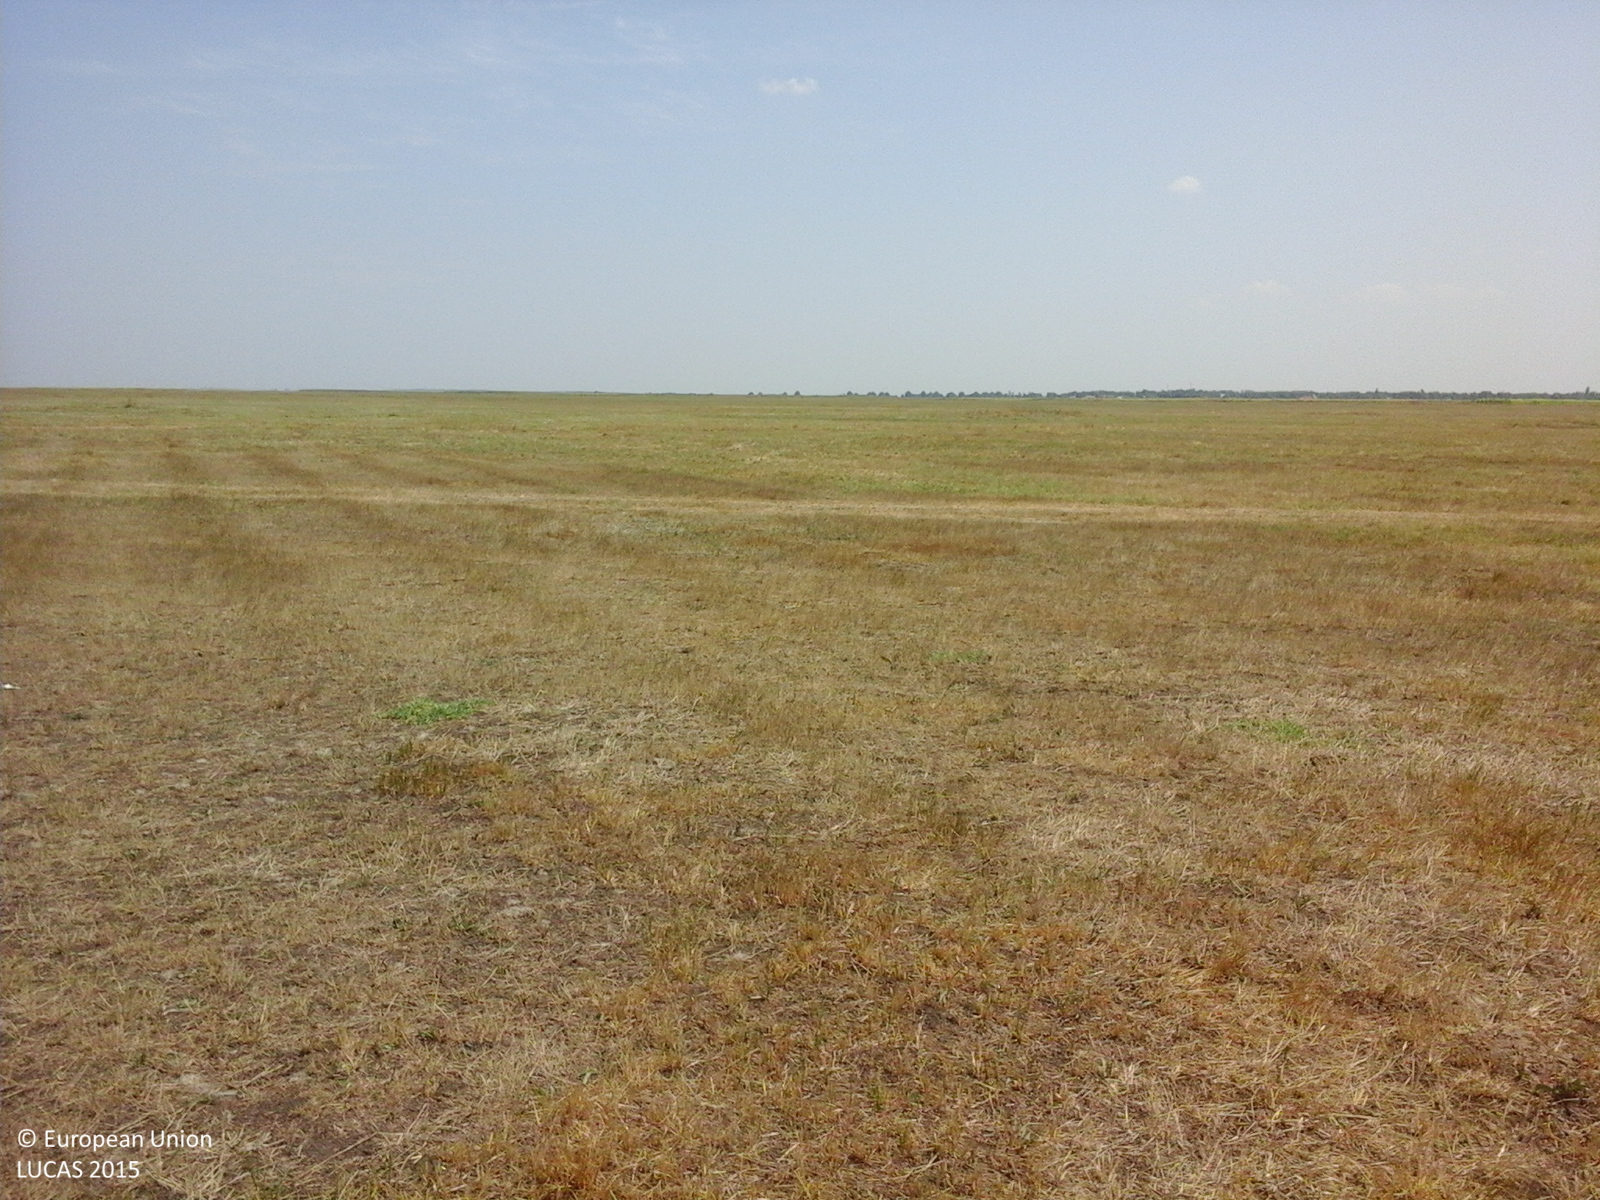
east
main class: Grassland
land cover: Grassland without tree/shrub cover
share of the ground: > 75 %
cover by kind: herbaceous plants 100 %
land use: Agriculture (excluding fallow land and kitchen gardens)
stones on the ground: < 10 %
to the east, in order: Grassland without tree/shrub cover
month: August
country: RO
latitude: 44.9971
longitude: 26.6536
